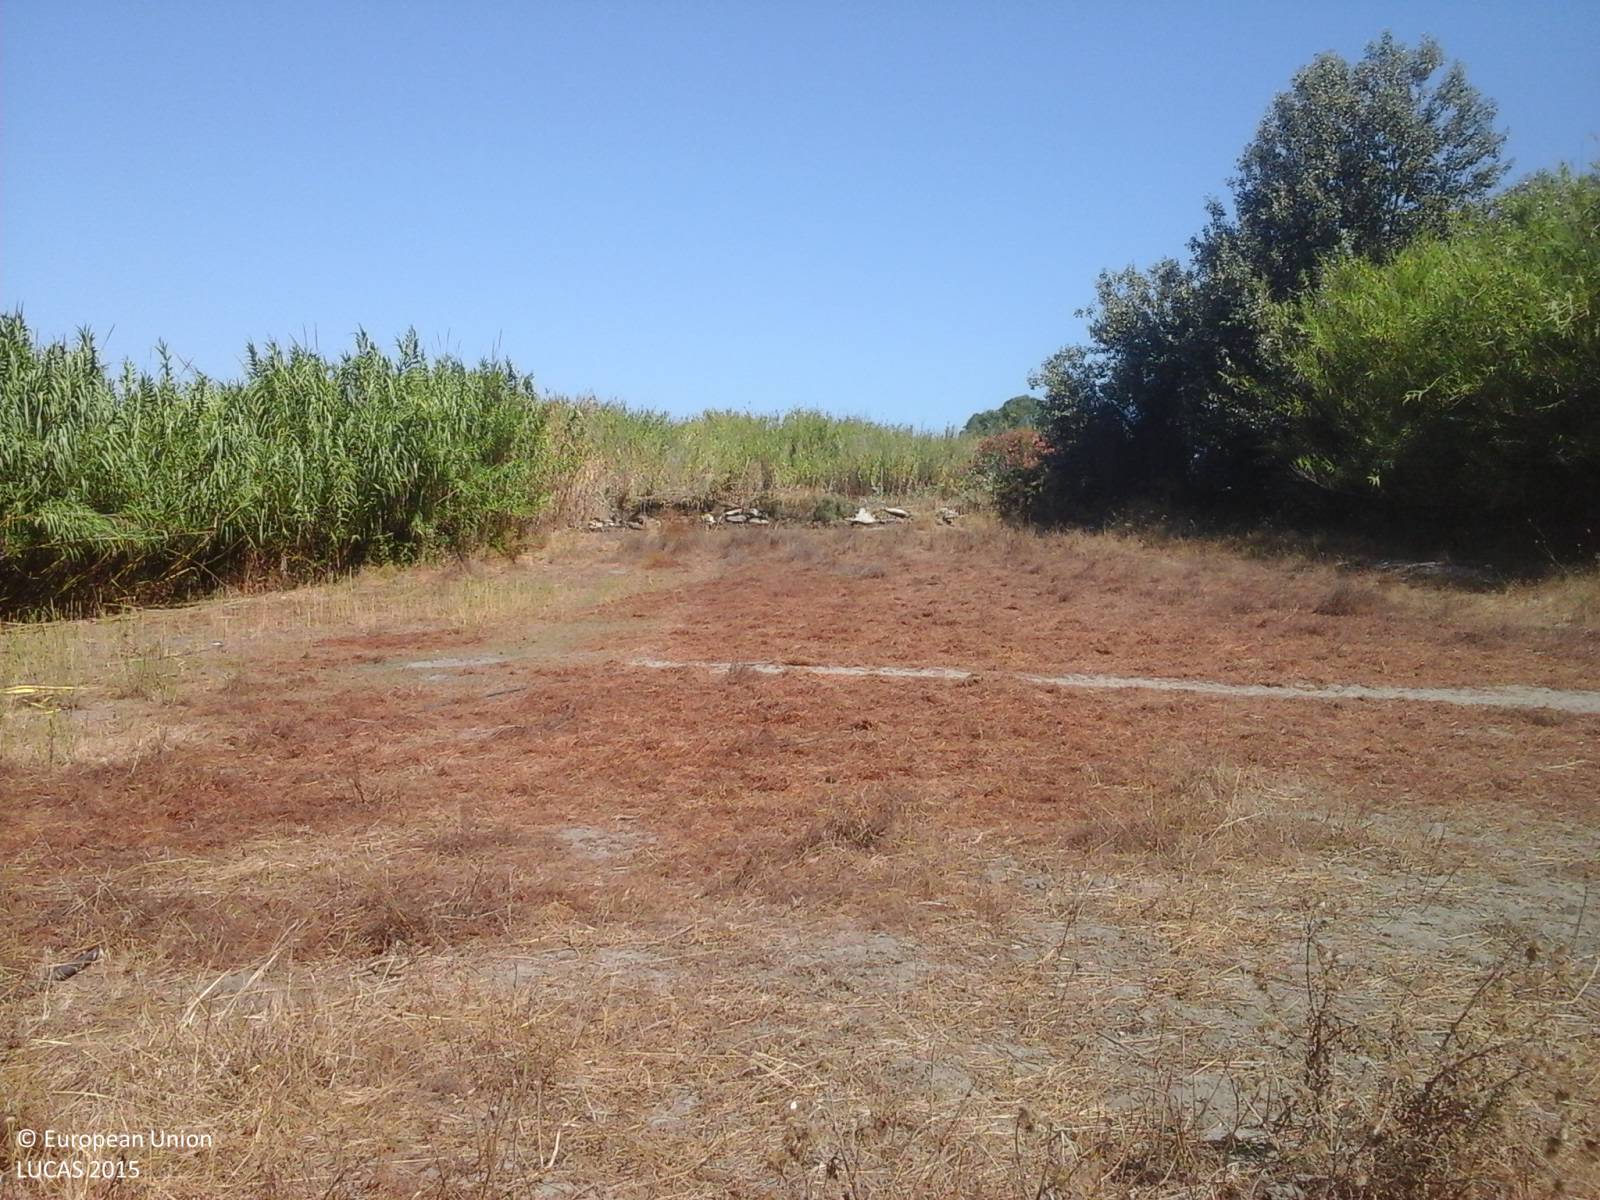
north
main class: Grassland
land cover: Spontaneously vegetated surfaces
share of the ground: > 75 %
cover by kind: herbaceous plants 85 %, unconsolidated bare surface 15 %
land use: Fallow land
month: July
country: IT
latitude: 39.2217
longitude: 8.3998
